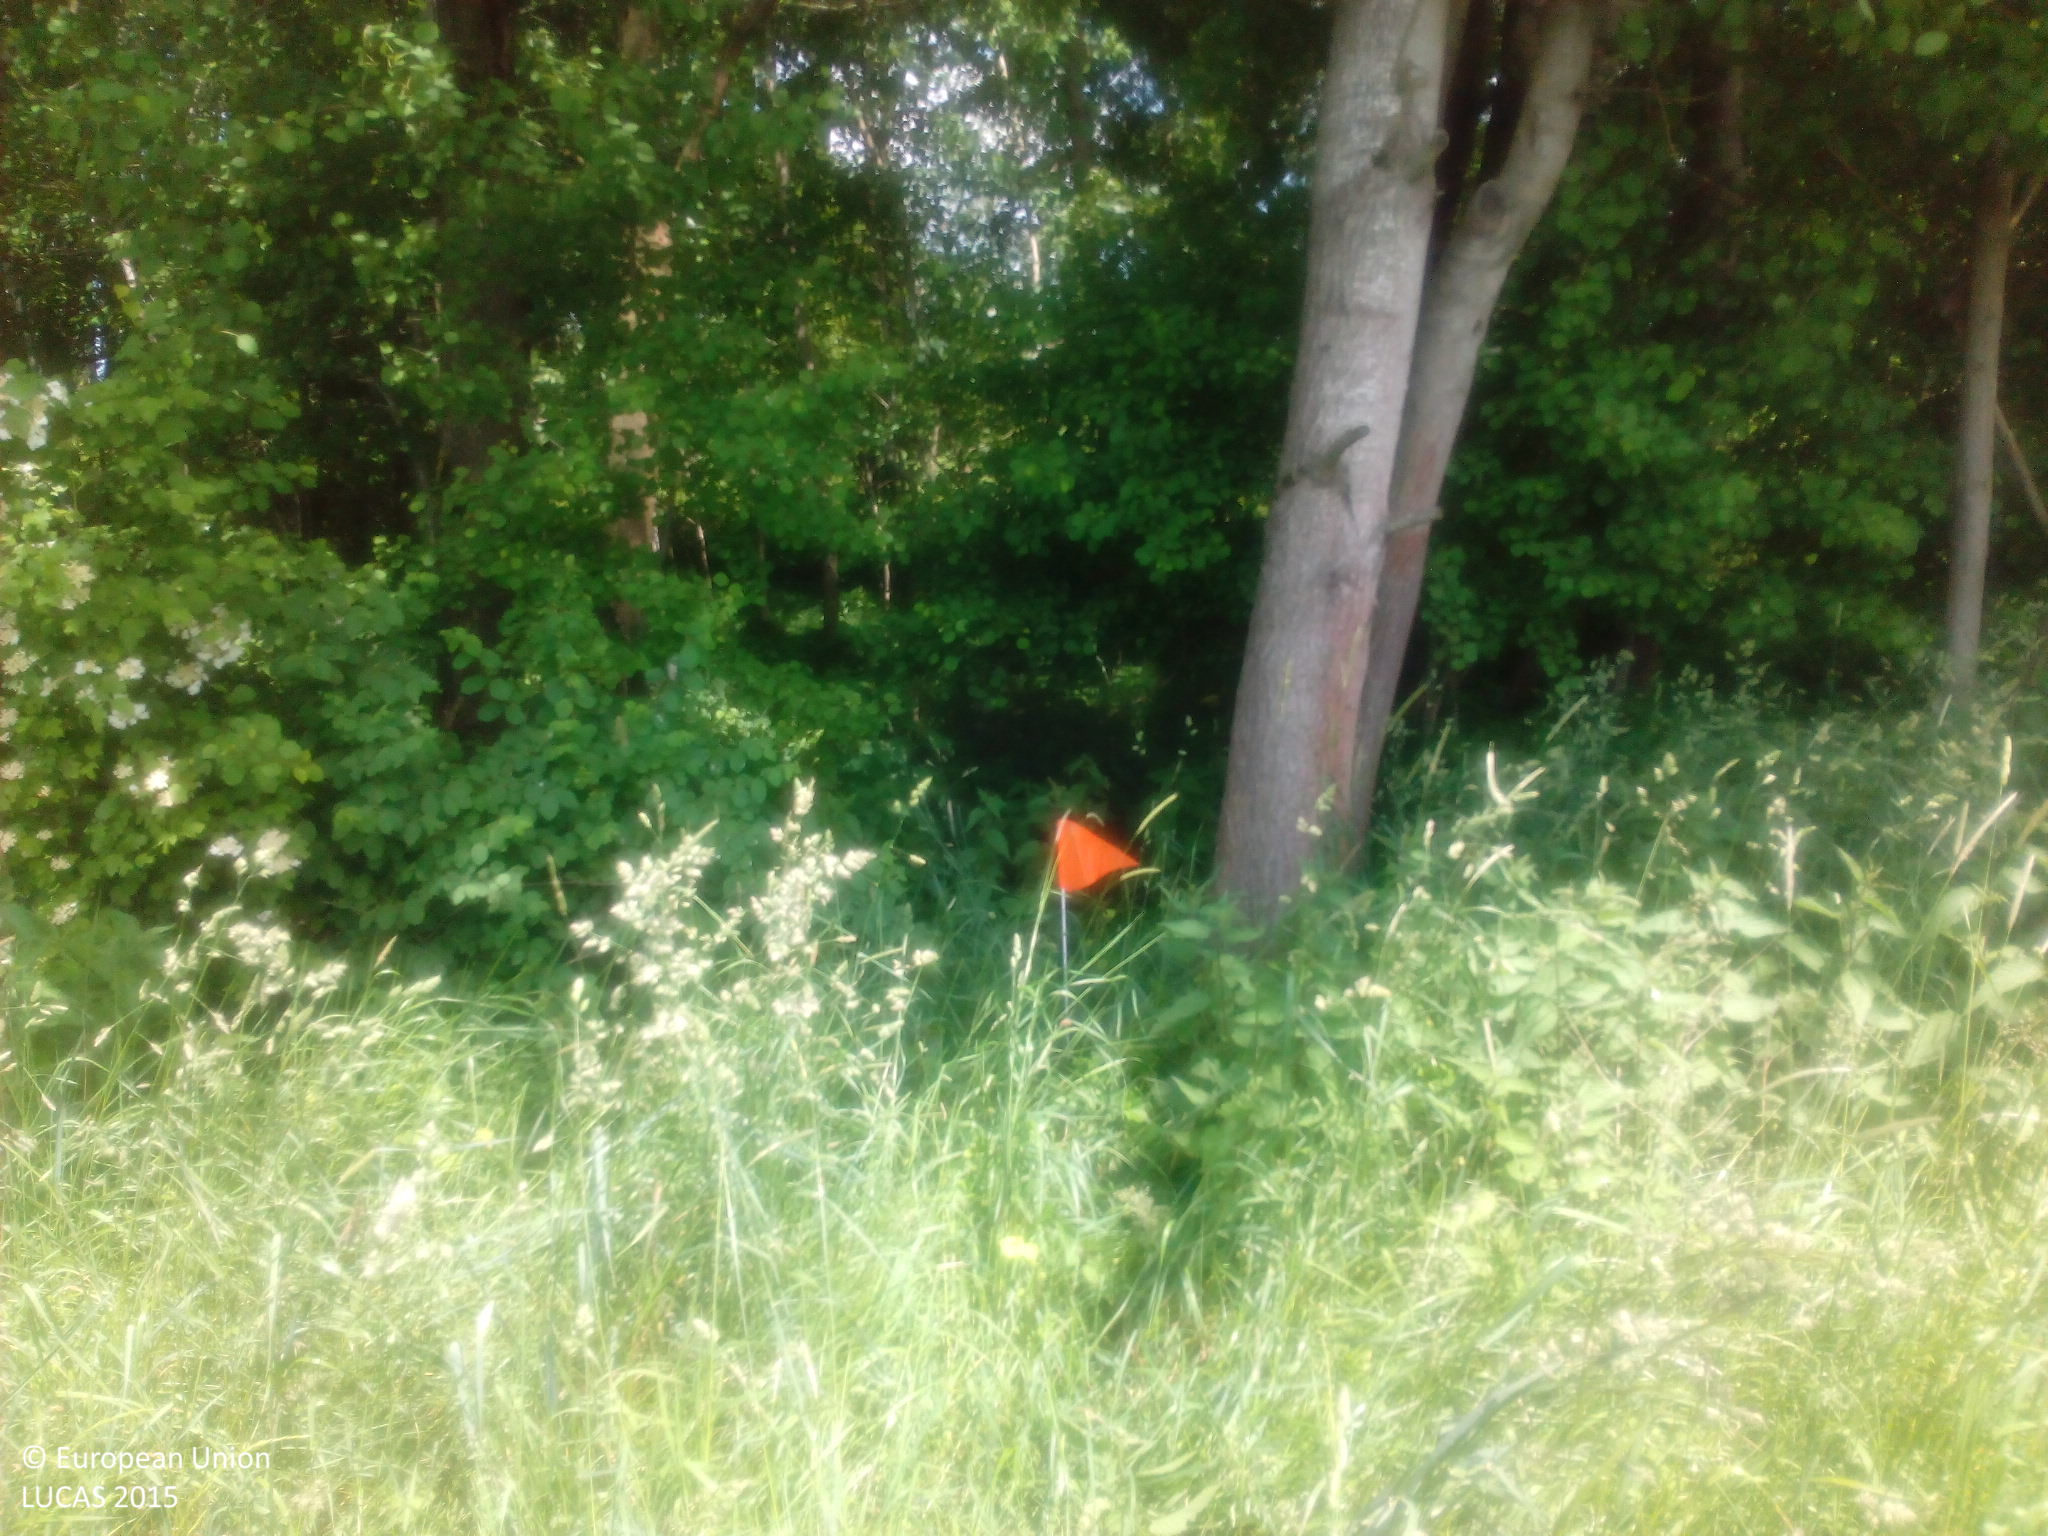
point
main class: Woodland
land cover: Broadleaved woodland
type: mesophytic deciduous forest
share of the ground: > 75 %
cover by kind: broadleaved forest trees 80 %, shrubs 10 %, herbaceous plants 10 %
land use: Forestry
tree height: > 5 m
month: June
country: DE
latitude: 48.4316
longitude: 12.3913
